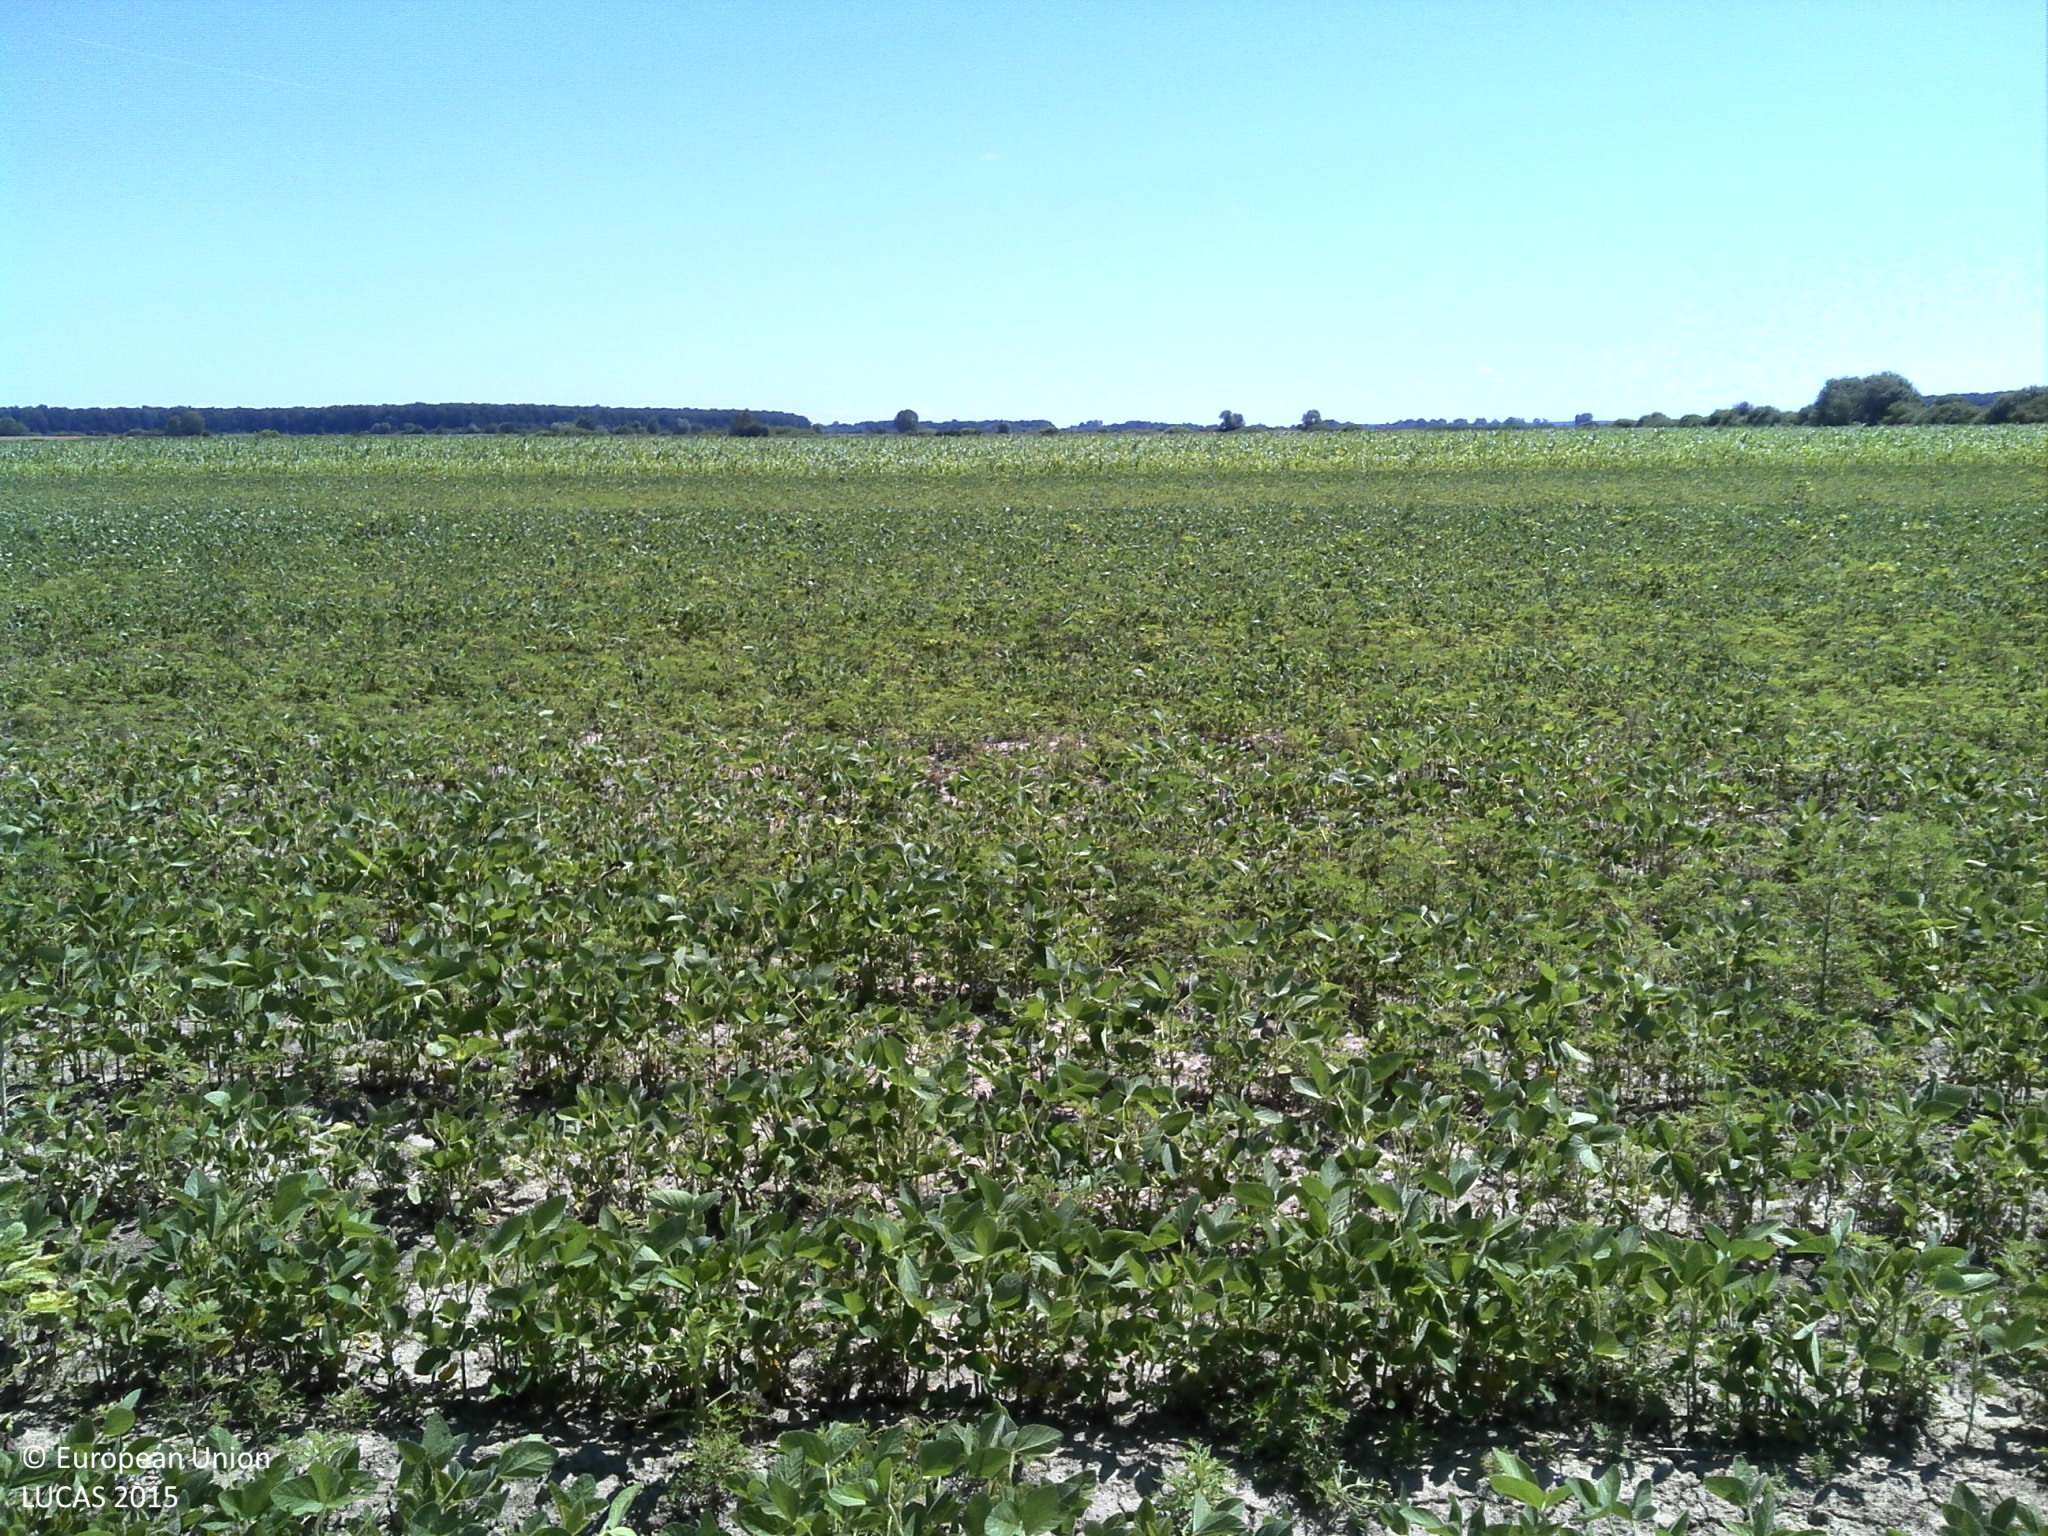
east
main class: Cropland
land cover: Soya
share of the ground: 50 - 75 %
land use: Agriculture (excluding fallow land and kitchen gardens)
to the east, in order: Soya; Maize
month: June
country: HR
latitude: 45.7446
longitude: 17.9866
